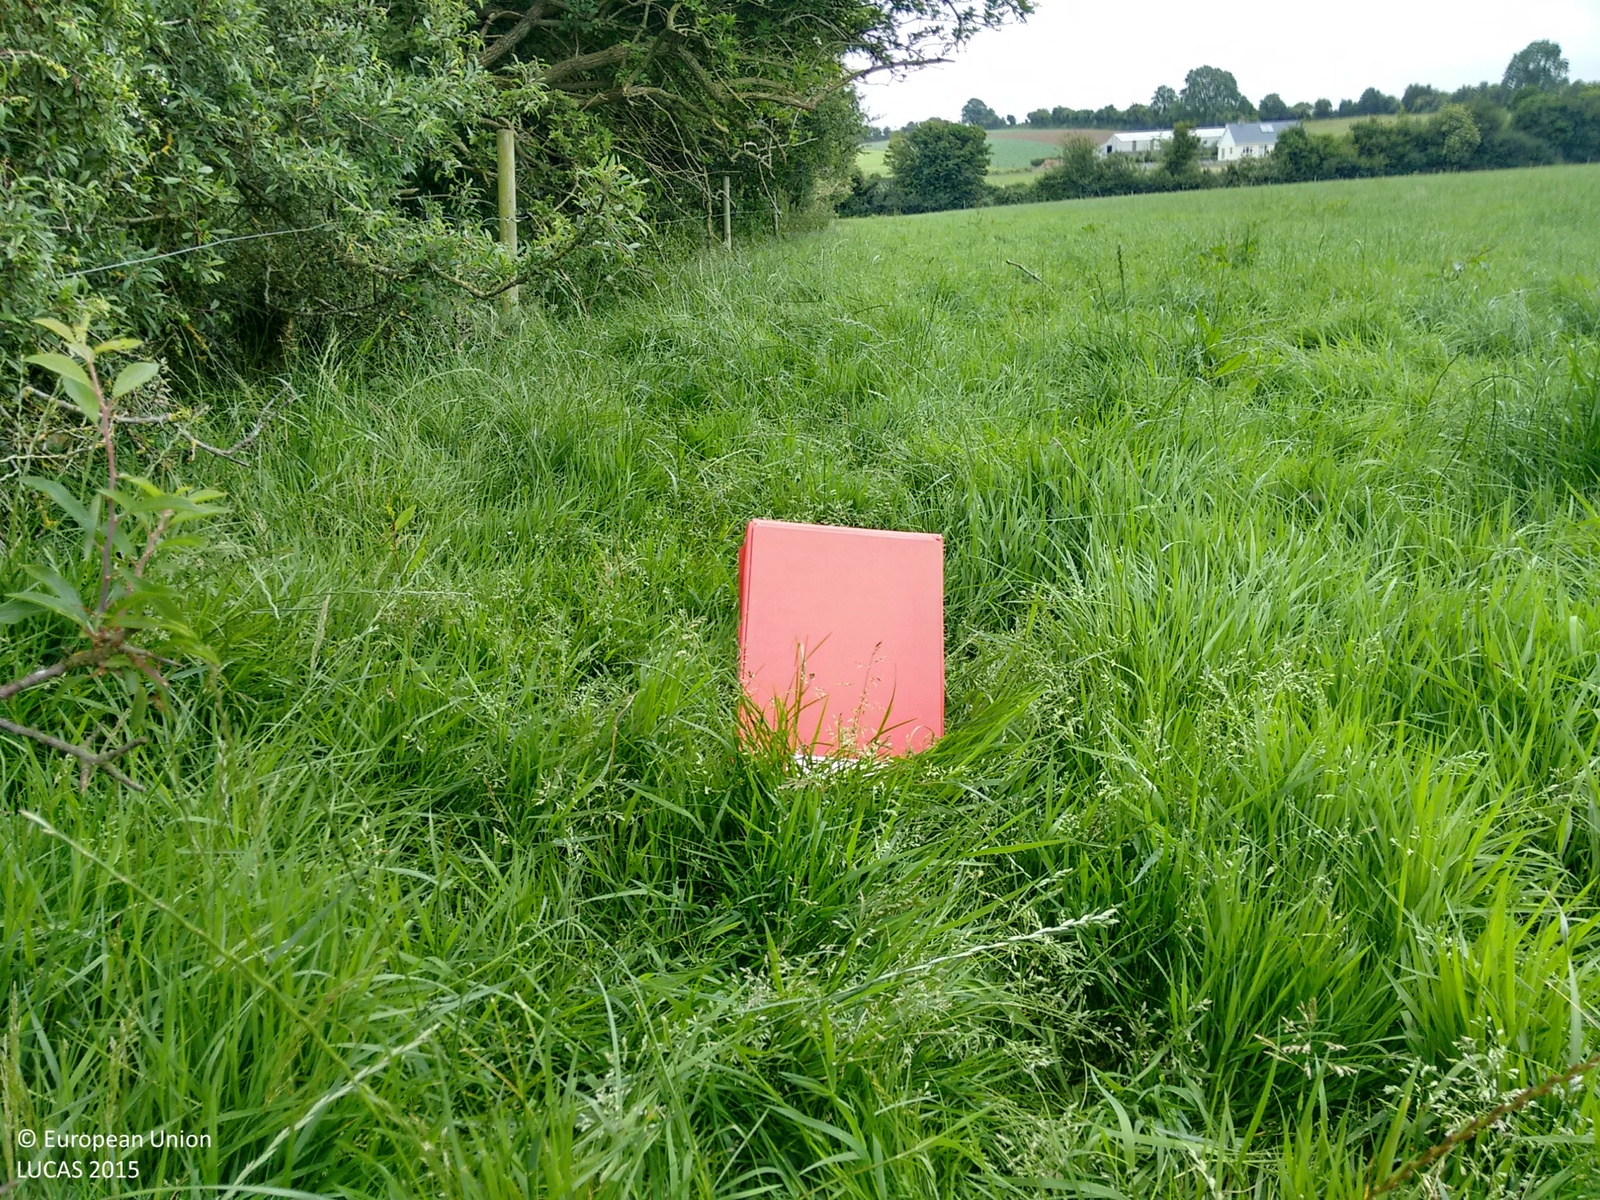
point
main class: Grassland
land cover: Grassland without tree/shrub cover
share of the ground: > 75 %
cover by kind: herbaceous plants 95 %, shrubs 5 %
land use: Agriculture (excluding fallow land and kitchen gardens)
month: July
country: IE
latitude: 52.2071
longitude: -8.4399
